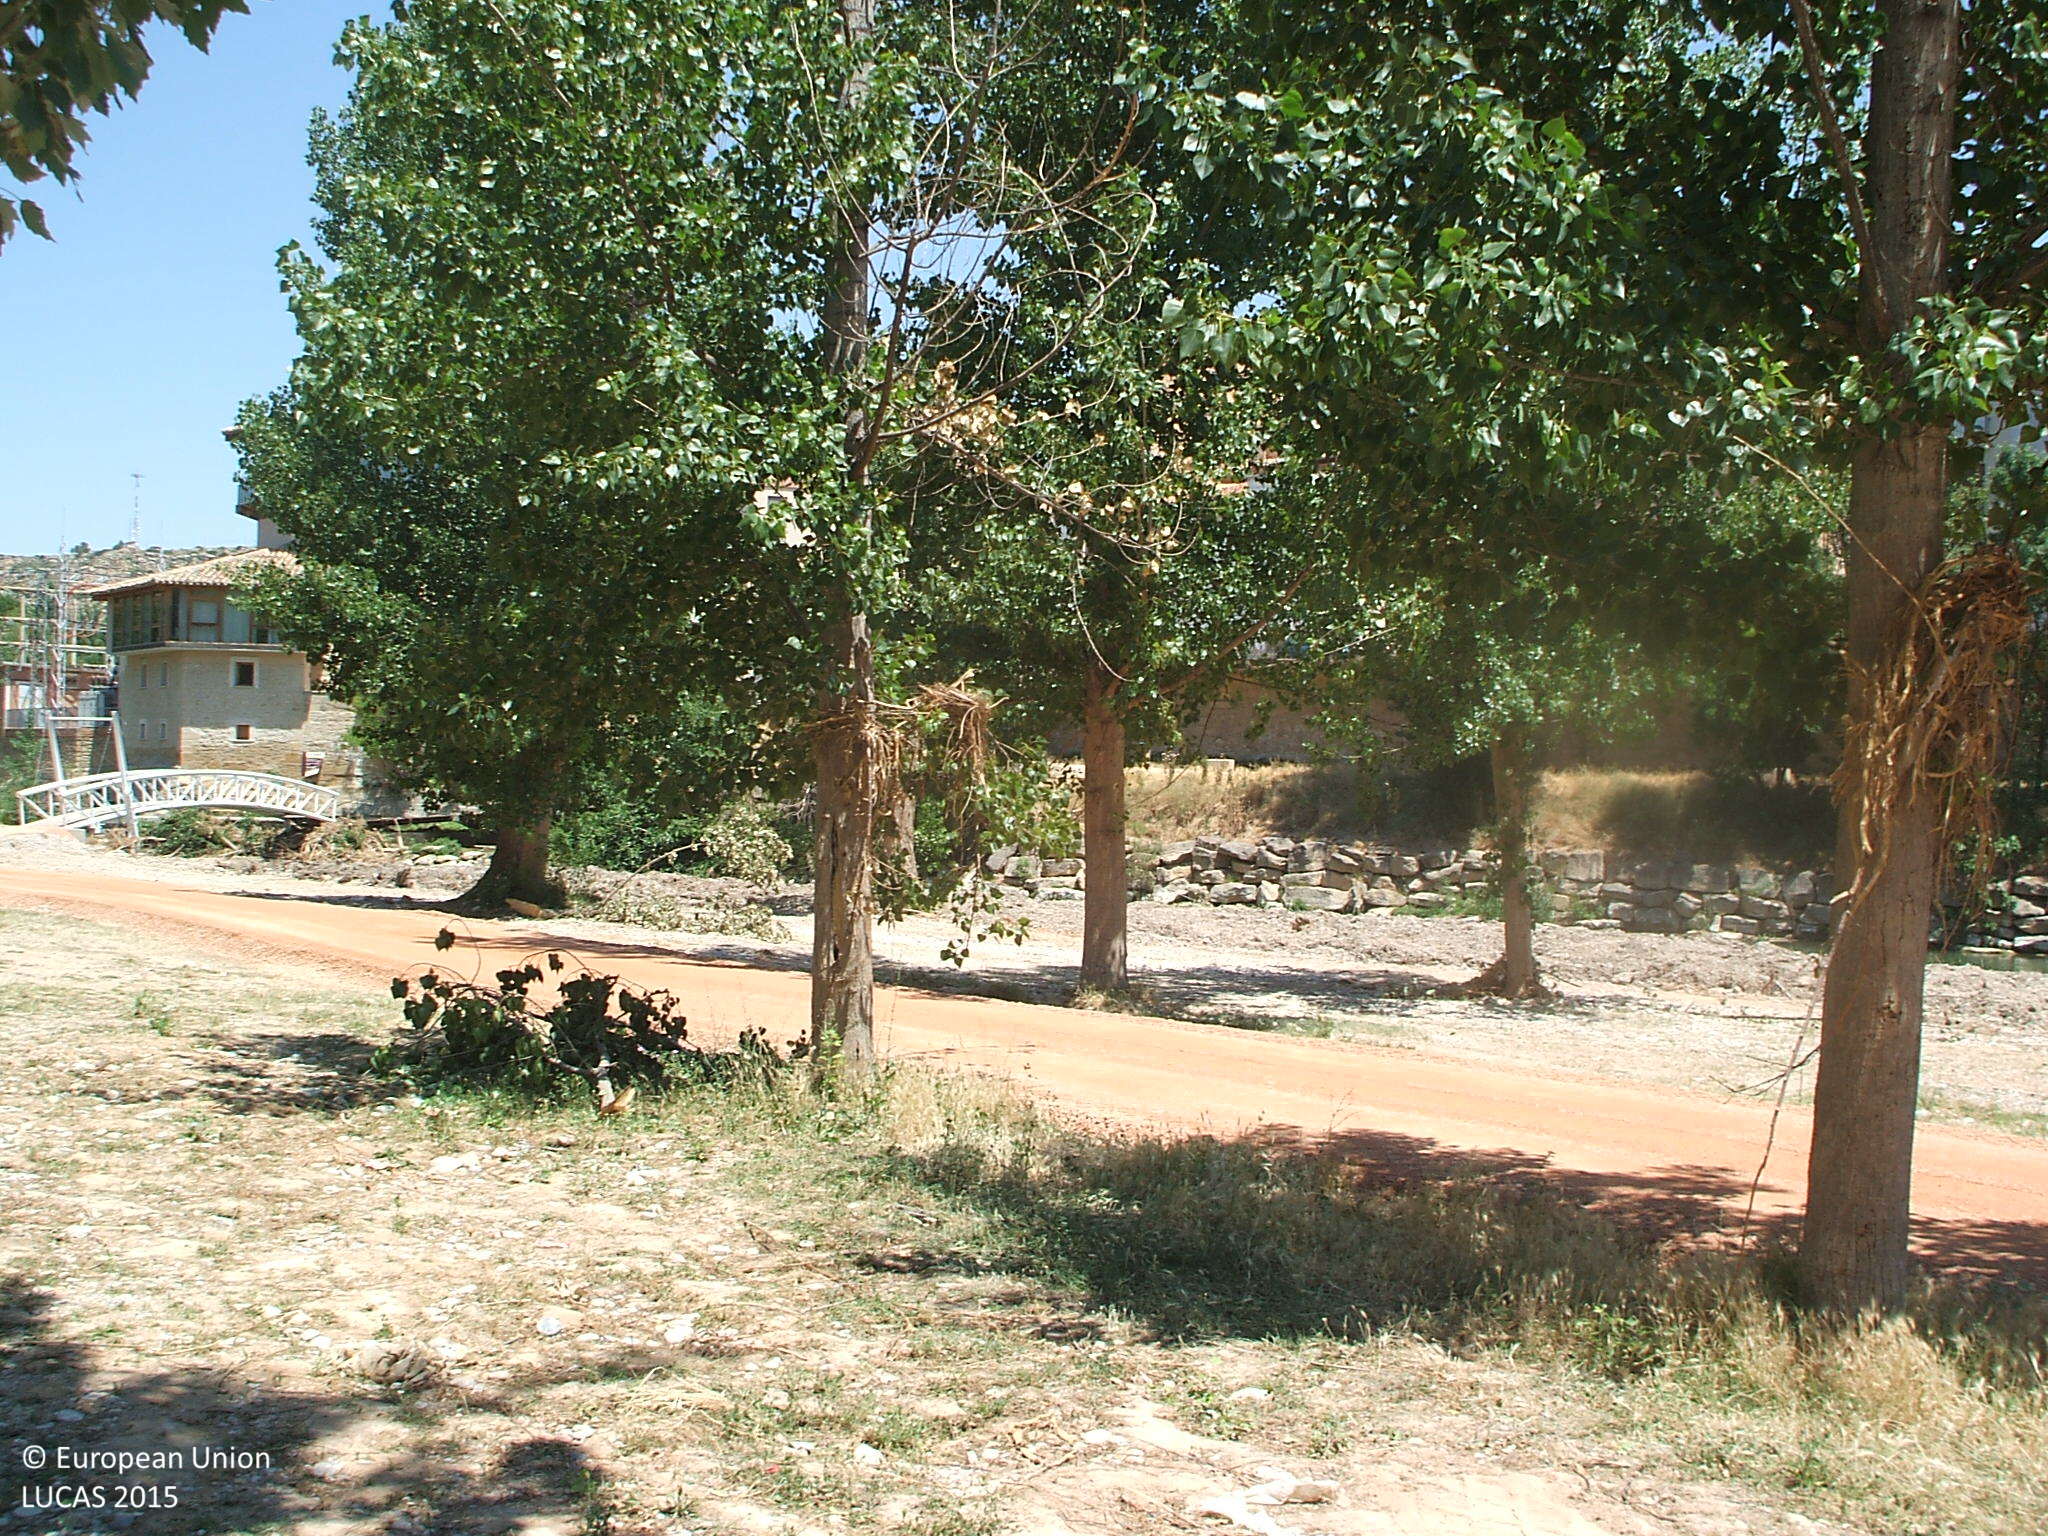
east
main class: Woodland
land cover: Broadleaved woodland
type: exotic forest
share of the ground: 50 - 75 %
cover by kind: broadleaved forest trees 60 %, unconsolidated bare surface 30 %, herbaceous plants 10 %
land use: Amenities, museums, leisure
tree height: > 5 m
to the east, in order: Broadleaved woodland; Tracks; Broadleaved woodland; Inland fresh running water; Dry stone walls; Abandoned hedges; Artificial constructions in urban areas
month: June
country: ES
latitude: 41.0524
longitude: -0.1366
